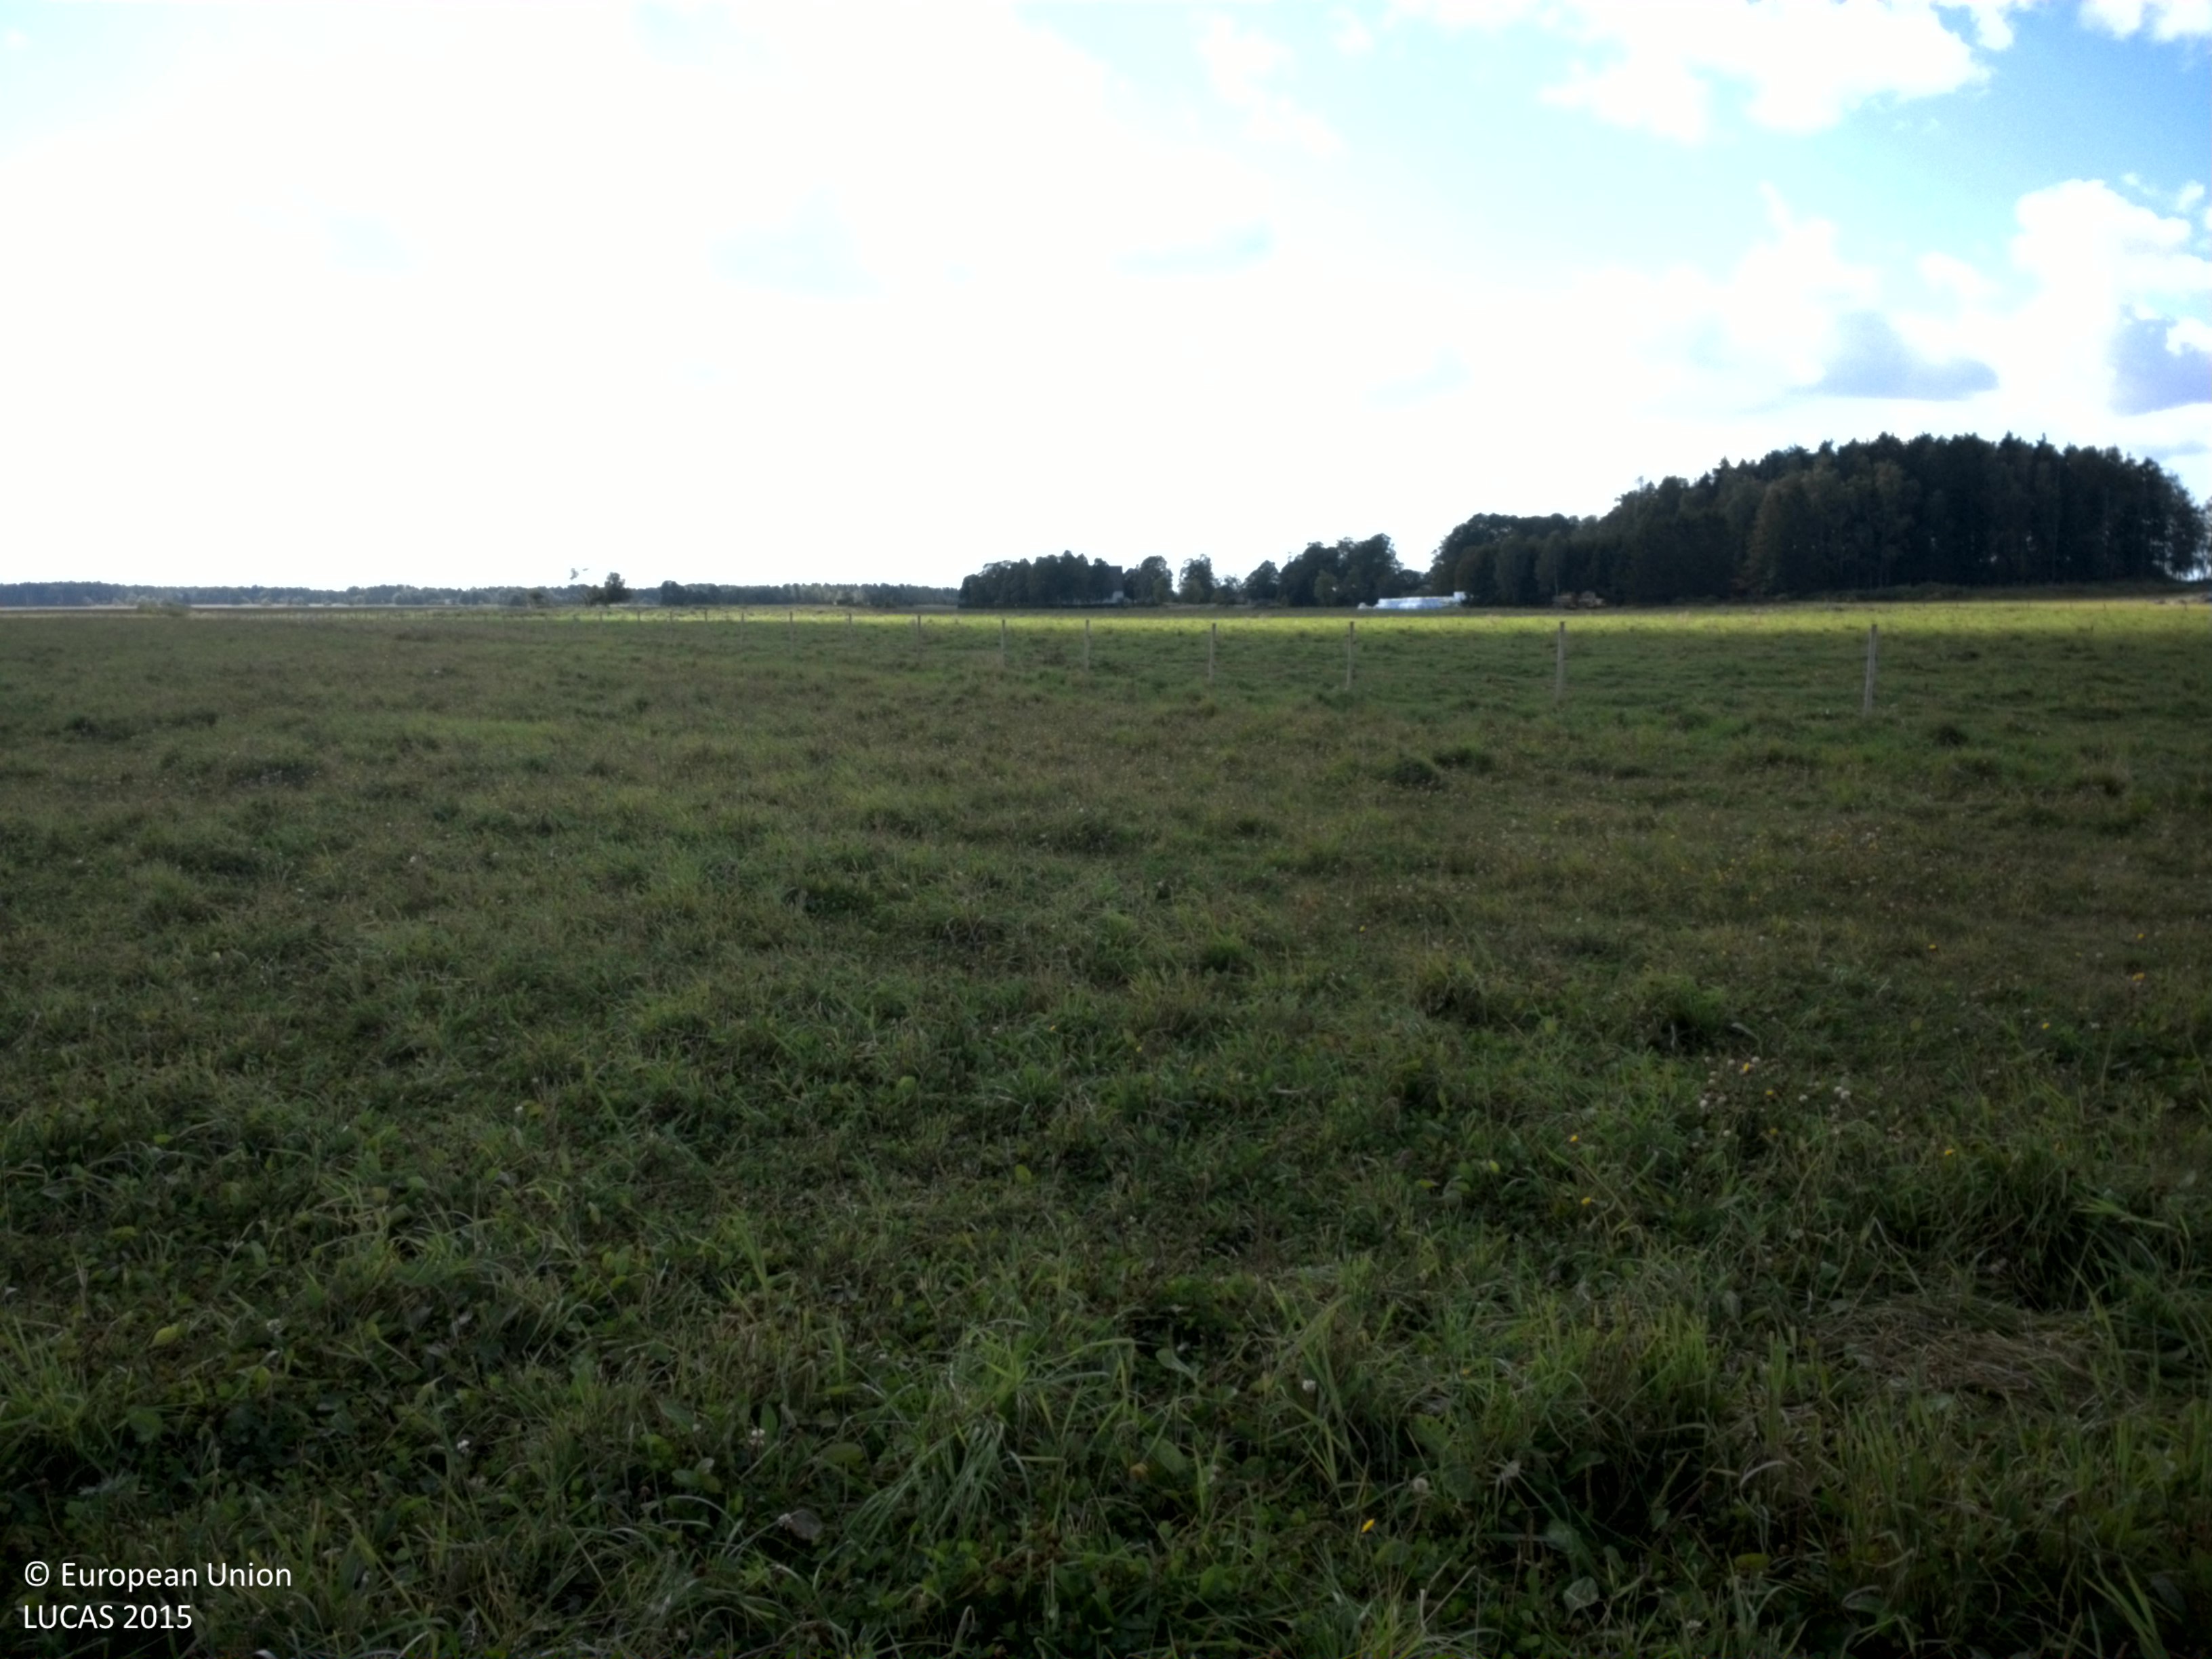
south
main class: Grassland
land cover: Grassland without tree/shrub cover
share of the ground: > 75 %
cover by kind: herbaceous plants 100 %
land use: Agriculture (excluding fallow land and kitchen gardens)
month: August
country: SE
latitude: 59.7007
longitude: 16.9764
